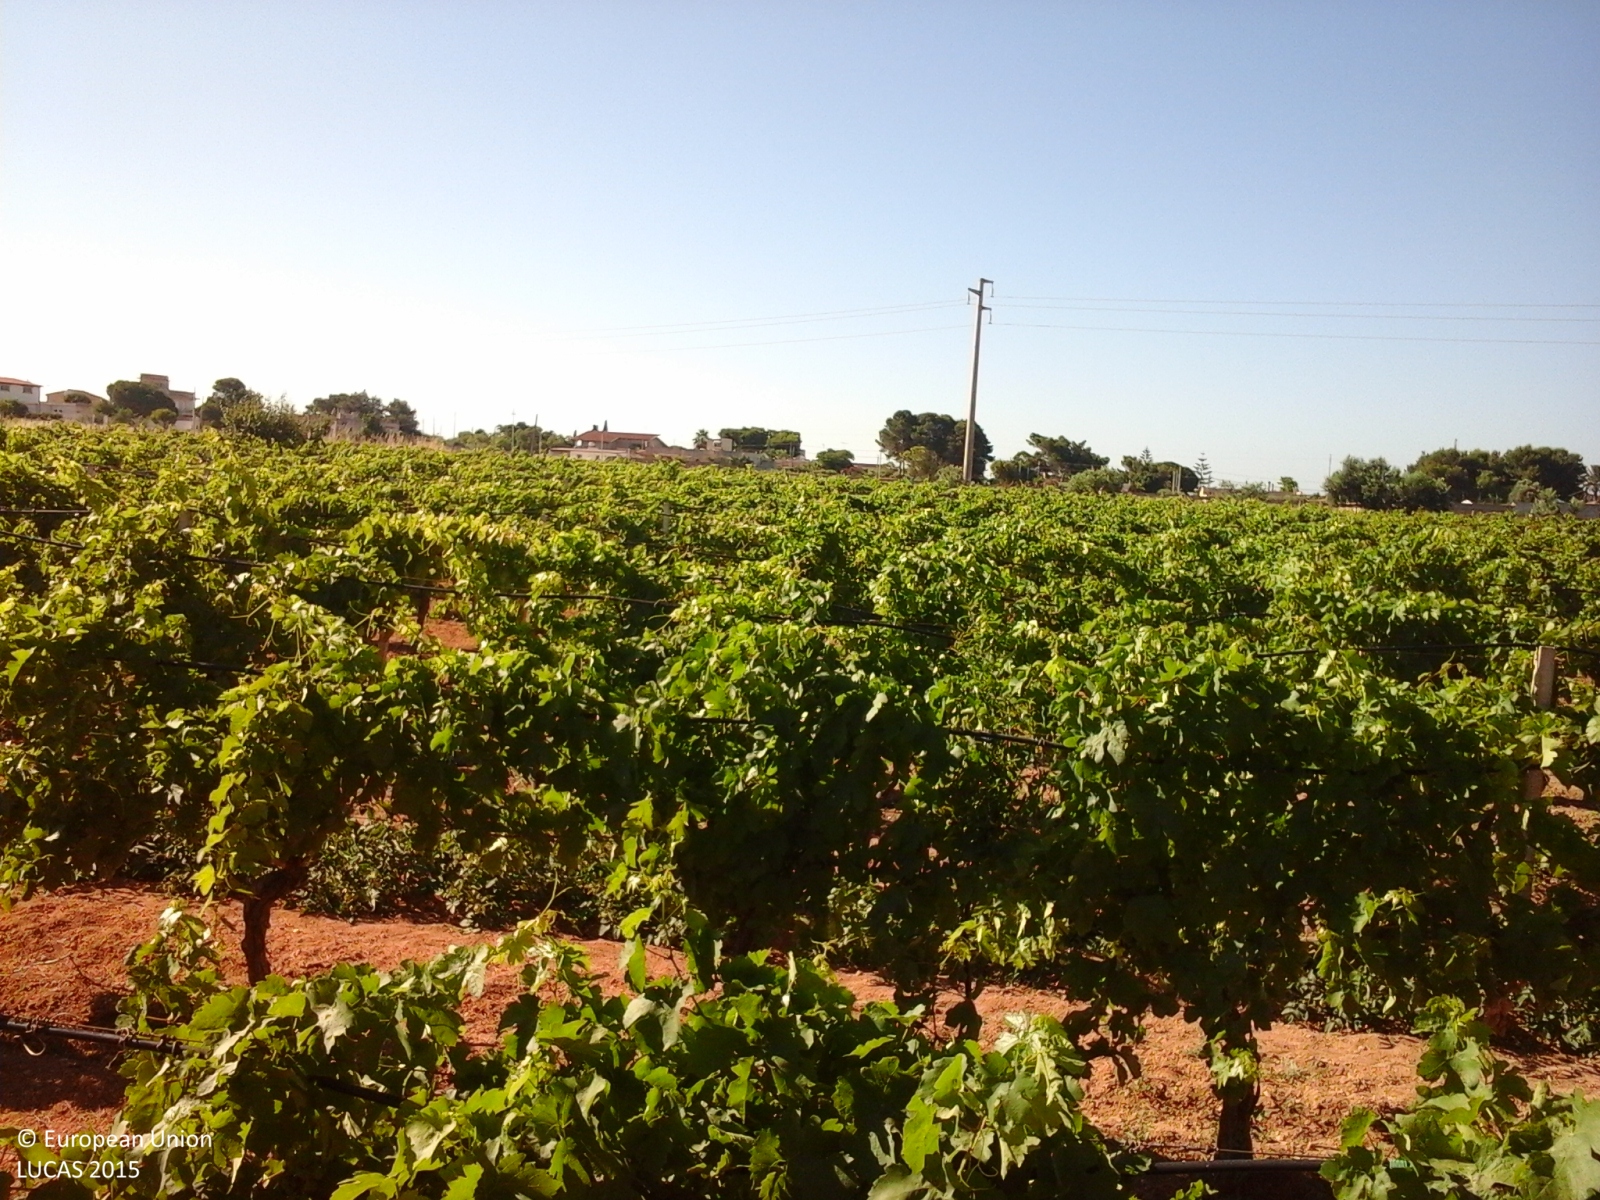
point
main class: Cropland
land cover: Vineyards
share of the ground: 10 - 25 %
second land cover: Other bare soil
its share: > 75 %
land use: Agriculture (excluding fallow land and kitchen gardens)
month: June
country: IT
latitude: 37.6570
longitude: 12.6212
